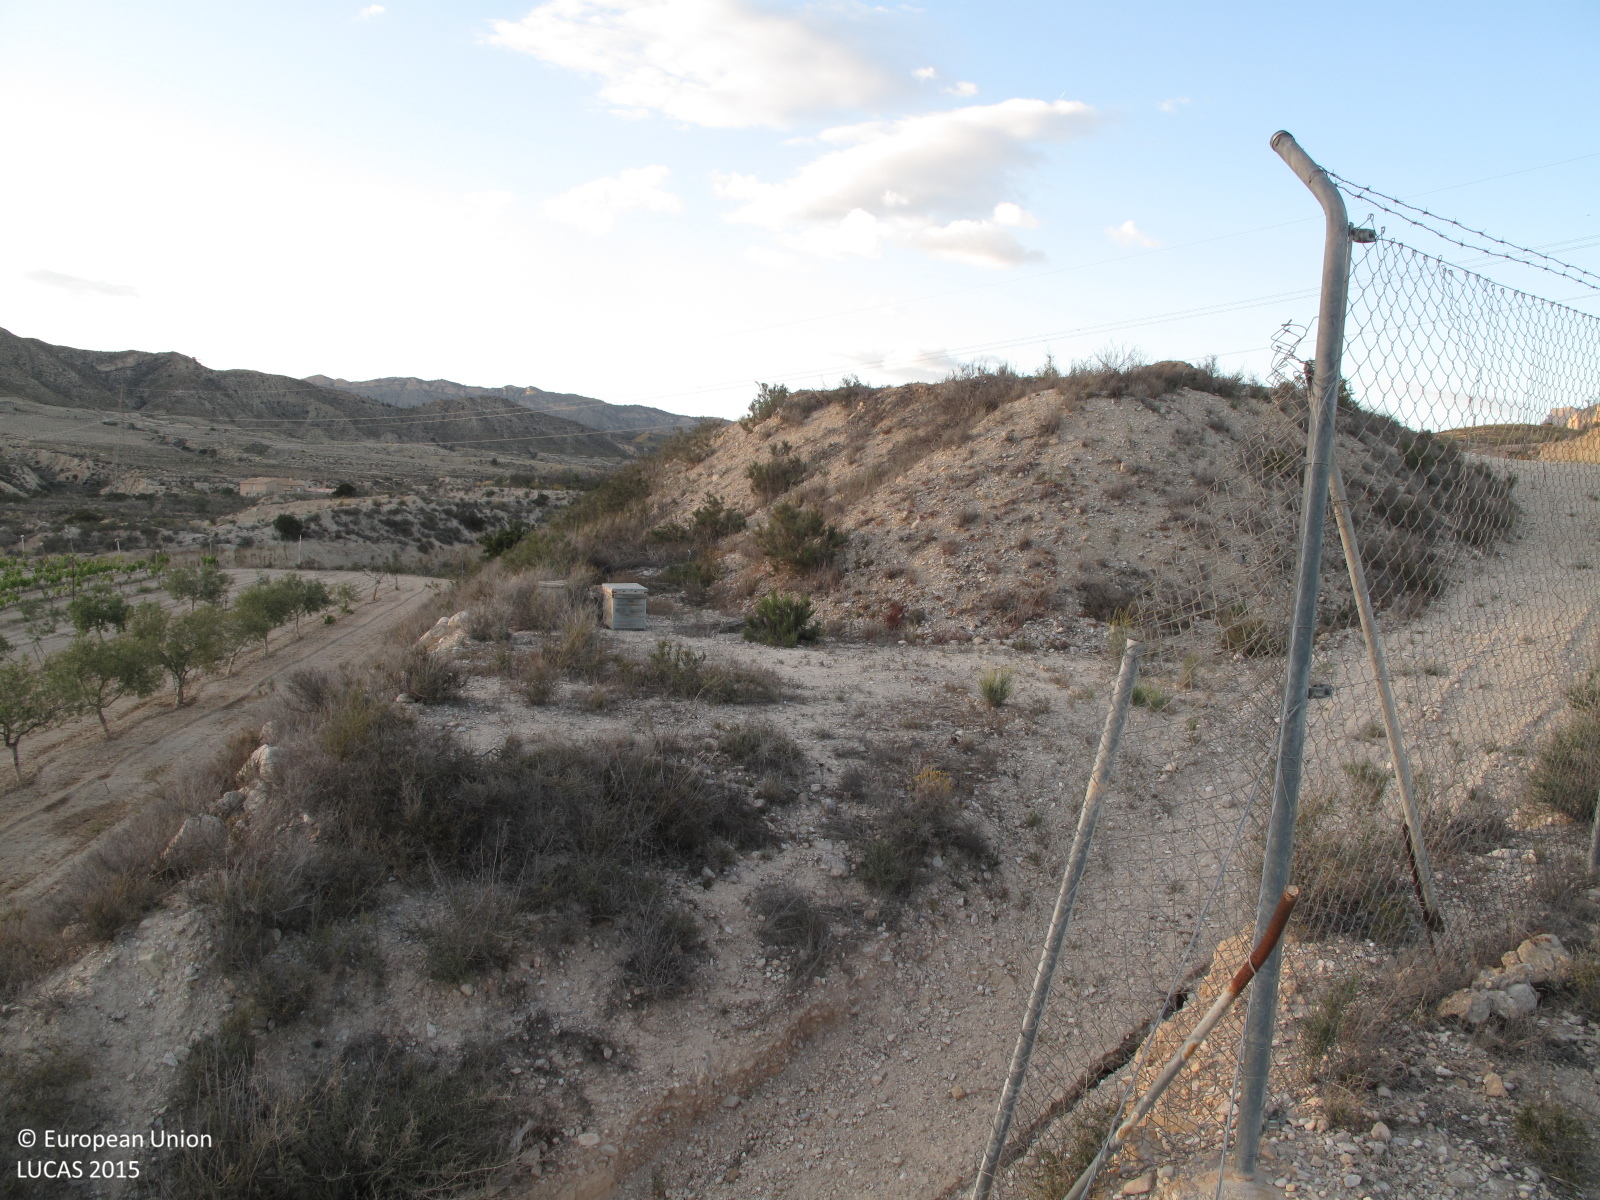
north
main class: Cropland
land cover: Olive groves
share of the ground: 10 - 25 %
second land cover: Other bare soil
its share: > 75 %
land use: Agriculture (excluding fallow land and kitchen gardens)
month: April
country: ES
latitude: 38.4850
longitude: -0.4535
